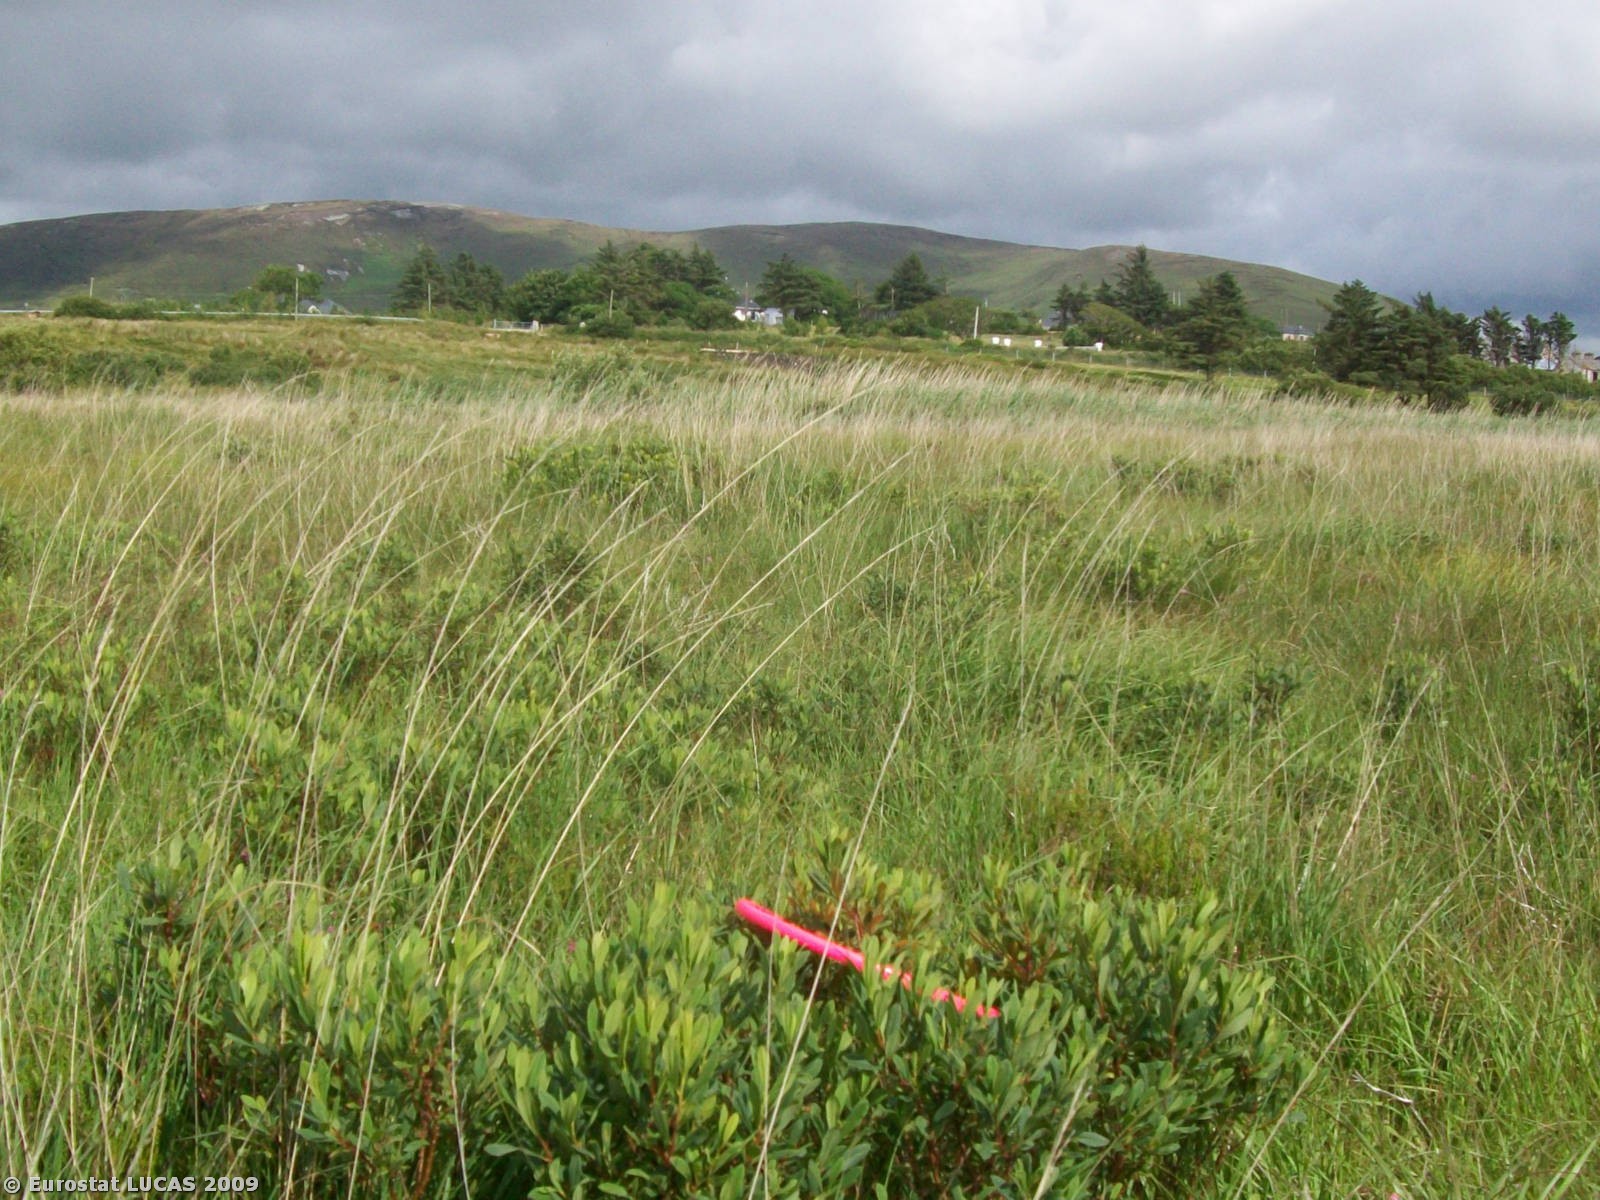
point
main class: Wetlands
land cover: Peatbogs
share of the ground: > 75 %
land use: Mining and quarrying
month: July
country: IE
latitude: 54.1600
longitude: -9.7687
